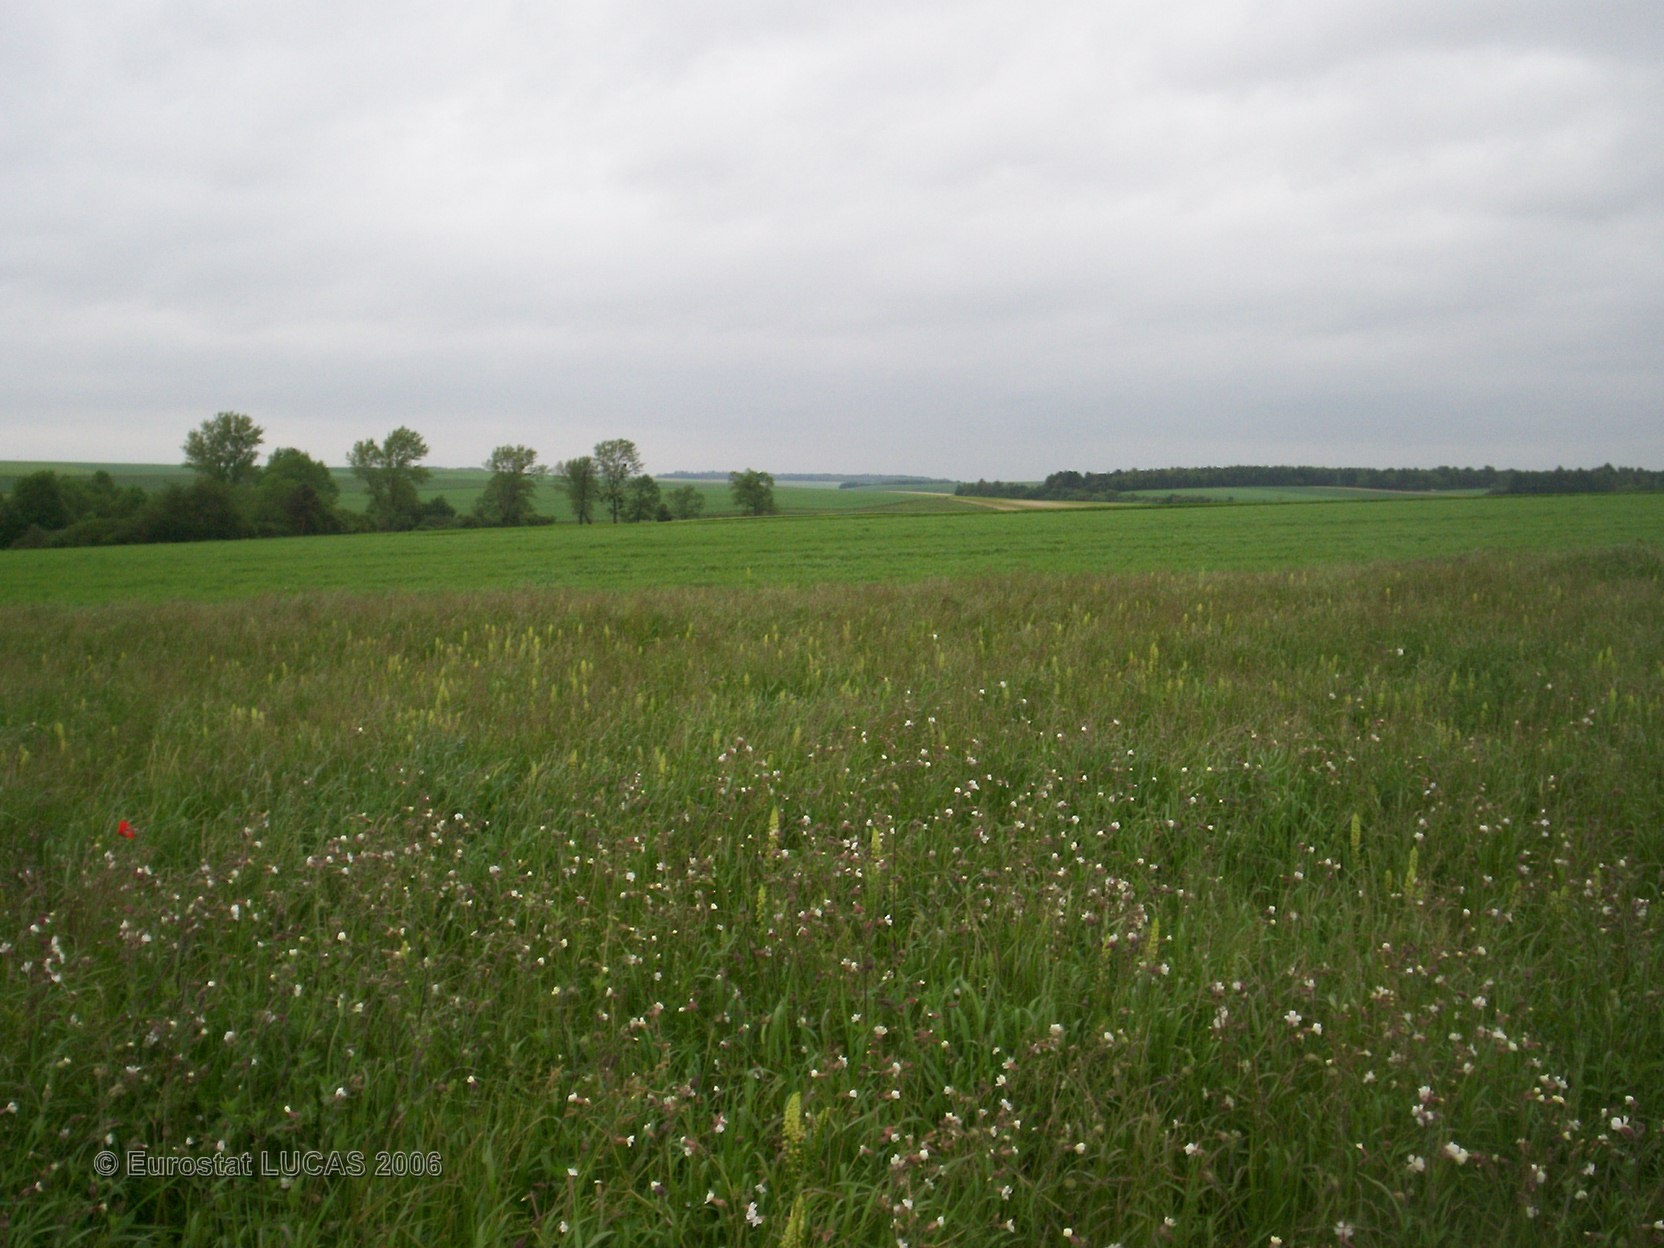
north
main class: Grassland
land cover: Grassland without tree/shrub cover
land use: Fallow land
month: May
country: FR
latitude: 49.3088
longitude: 4.4257
